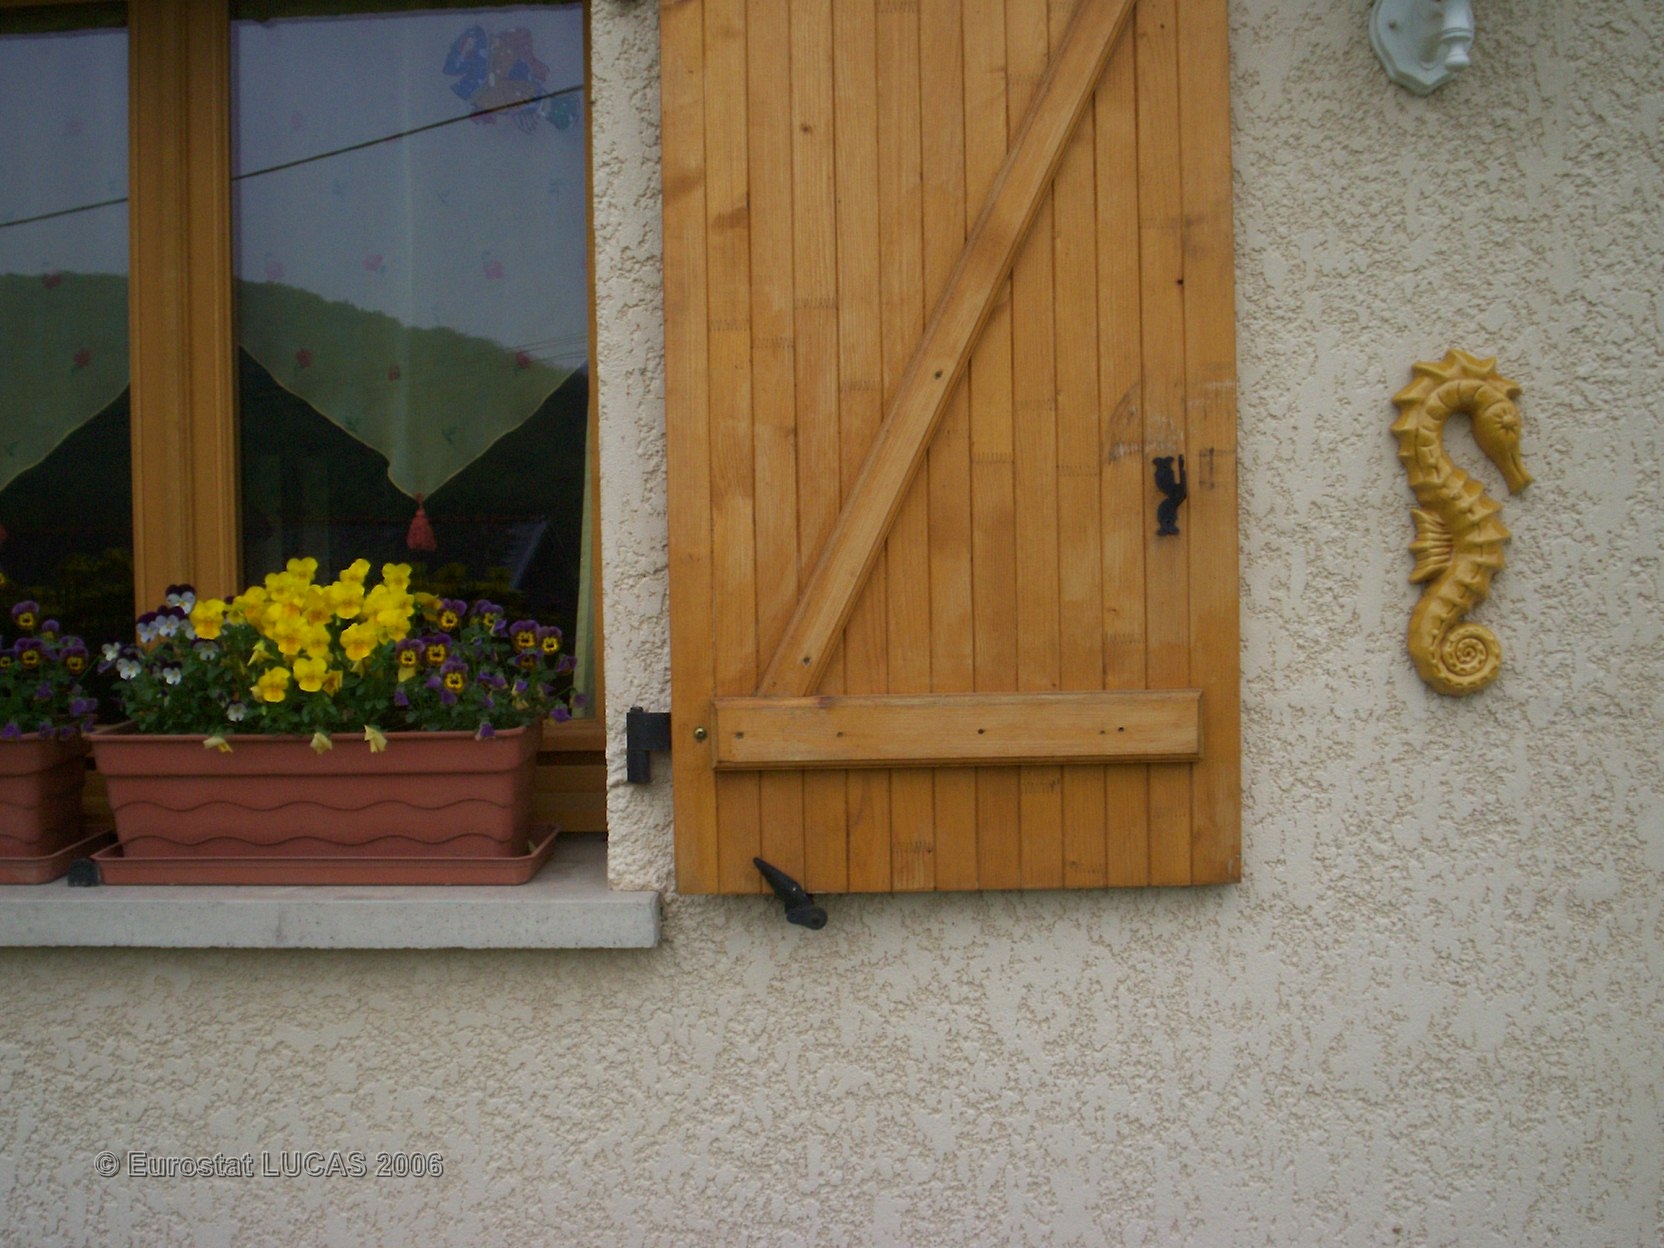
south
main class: Grassland
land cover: Grassland without tree/shrub cover
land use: Residential
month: May
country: FR
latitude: 49.8127
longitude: 4.7855
